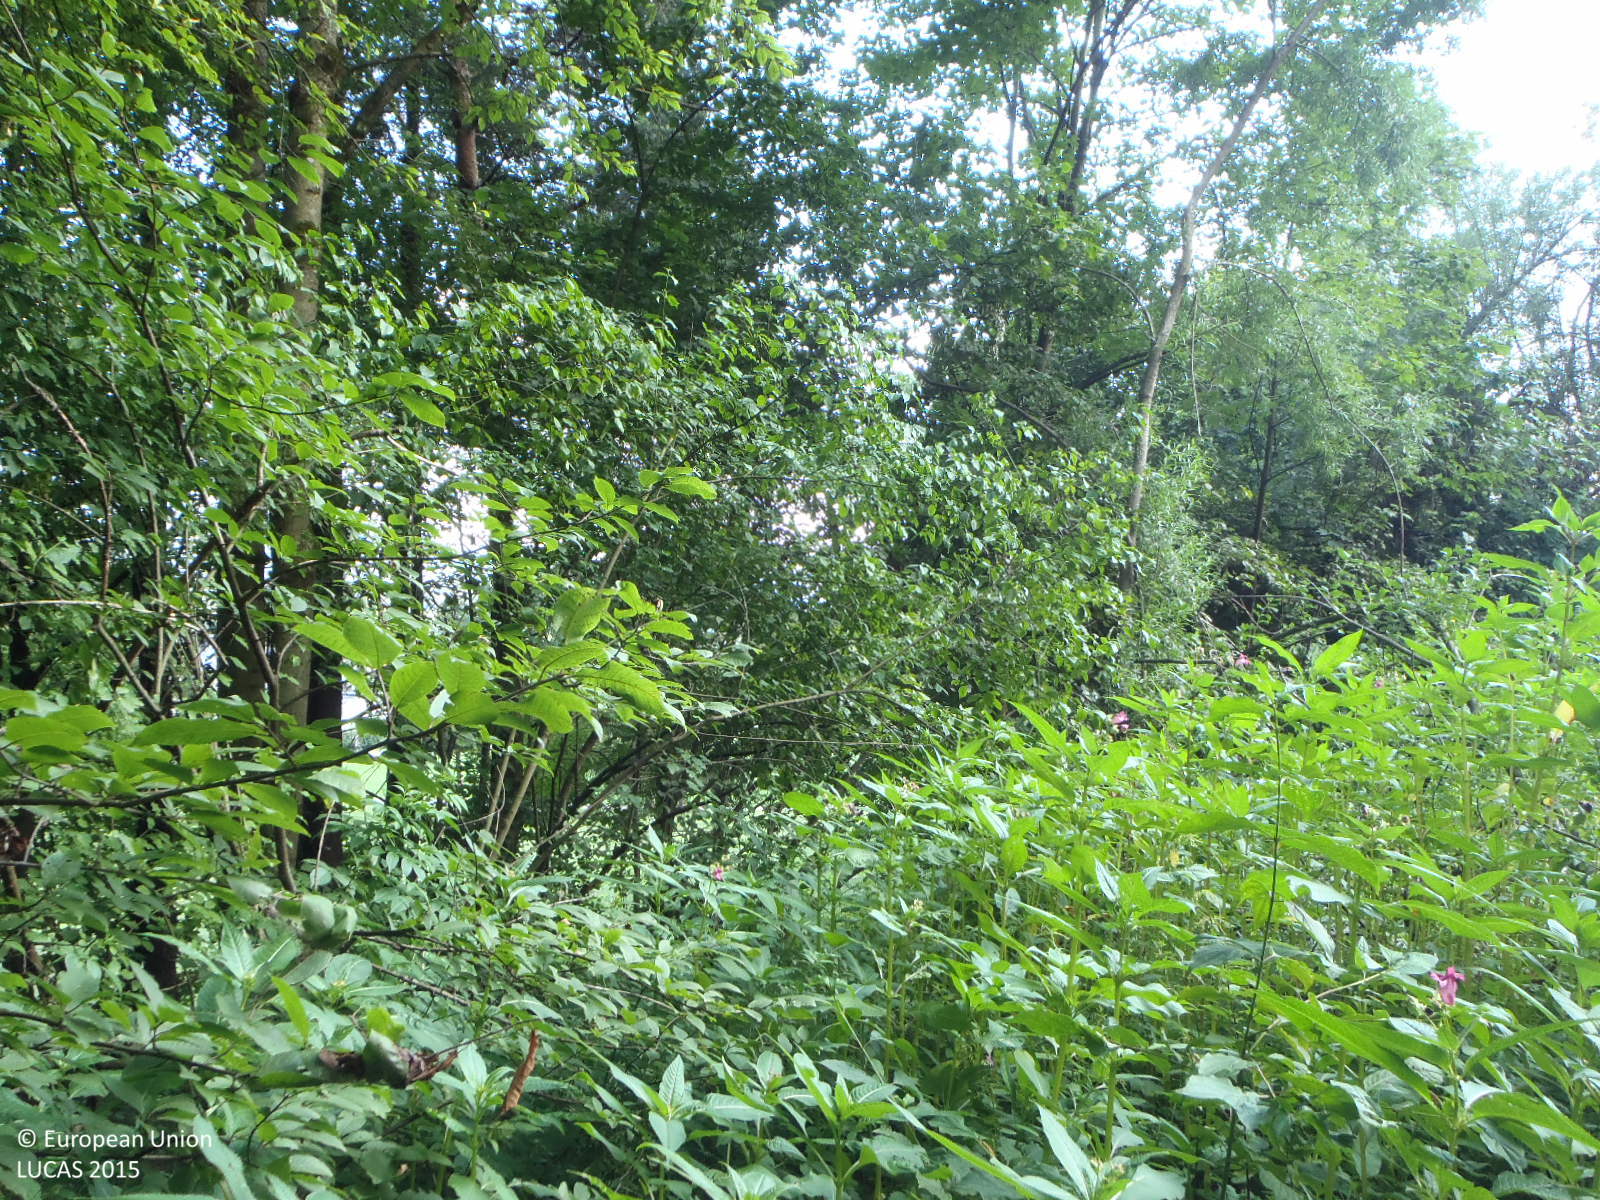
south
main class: Woodland
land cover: Broadleaved woodland
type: mountainous beech forest
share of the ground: > 75 %
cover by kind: broadleaved forest trees 60 %, coniferous forest trees 20 %, herbaceous plants 15 %, shrubs 5 %
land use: Forestry
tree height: > 5 m
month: July
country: AT
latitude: 47.5552
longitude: 12.1115
